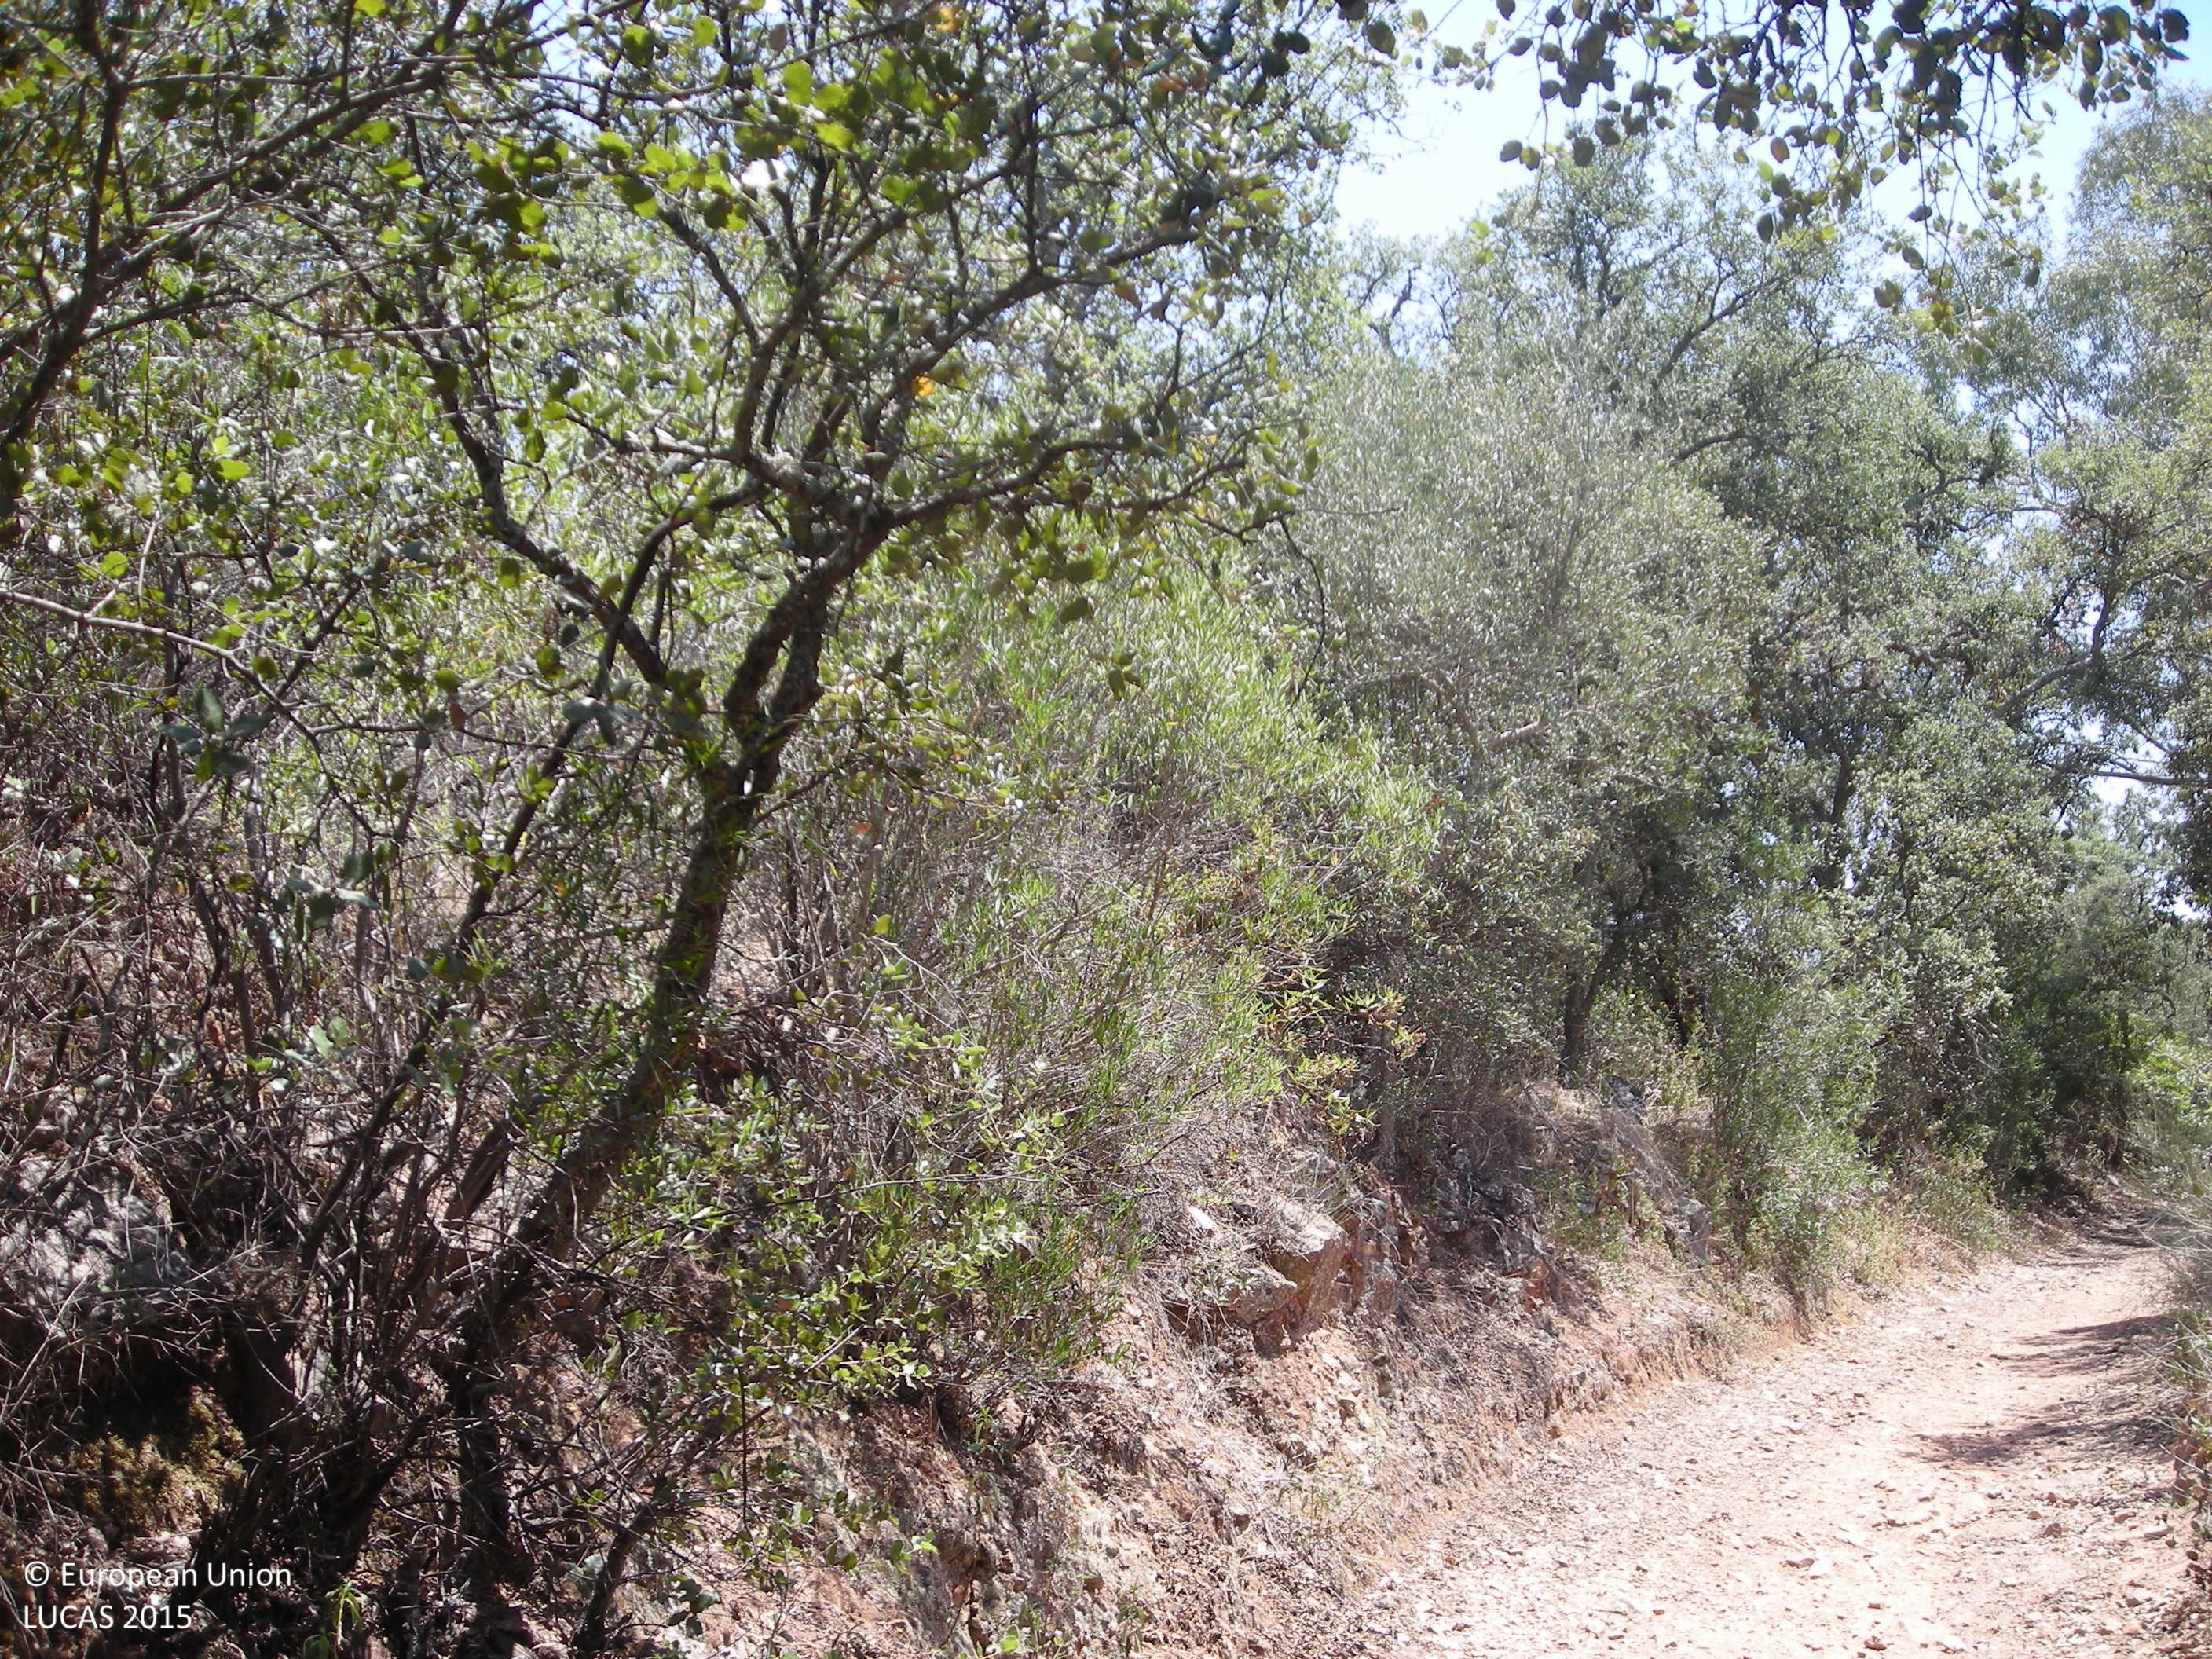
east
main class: Shrubland
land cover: Shrubland without tree cover
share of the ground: > 75 %
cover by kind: shrubs 100 %
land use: Semi-natural and natural areas not in use
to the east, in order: Shrubland without tree cover; Tracks; Shrubland without tree cover
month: June
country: ES
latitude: 39.0858
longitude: -5.4783
